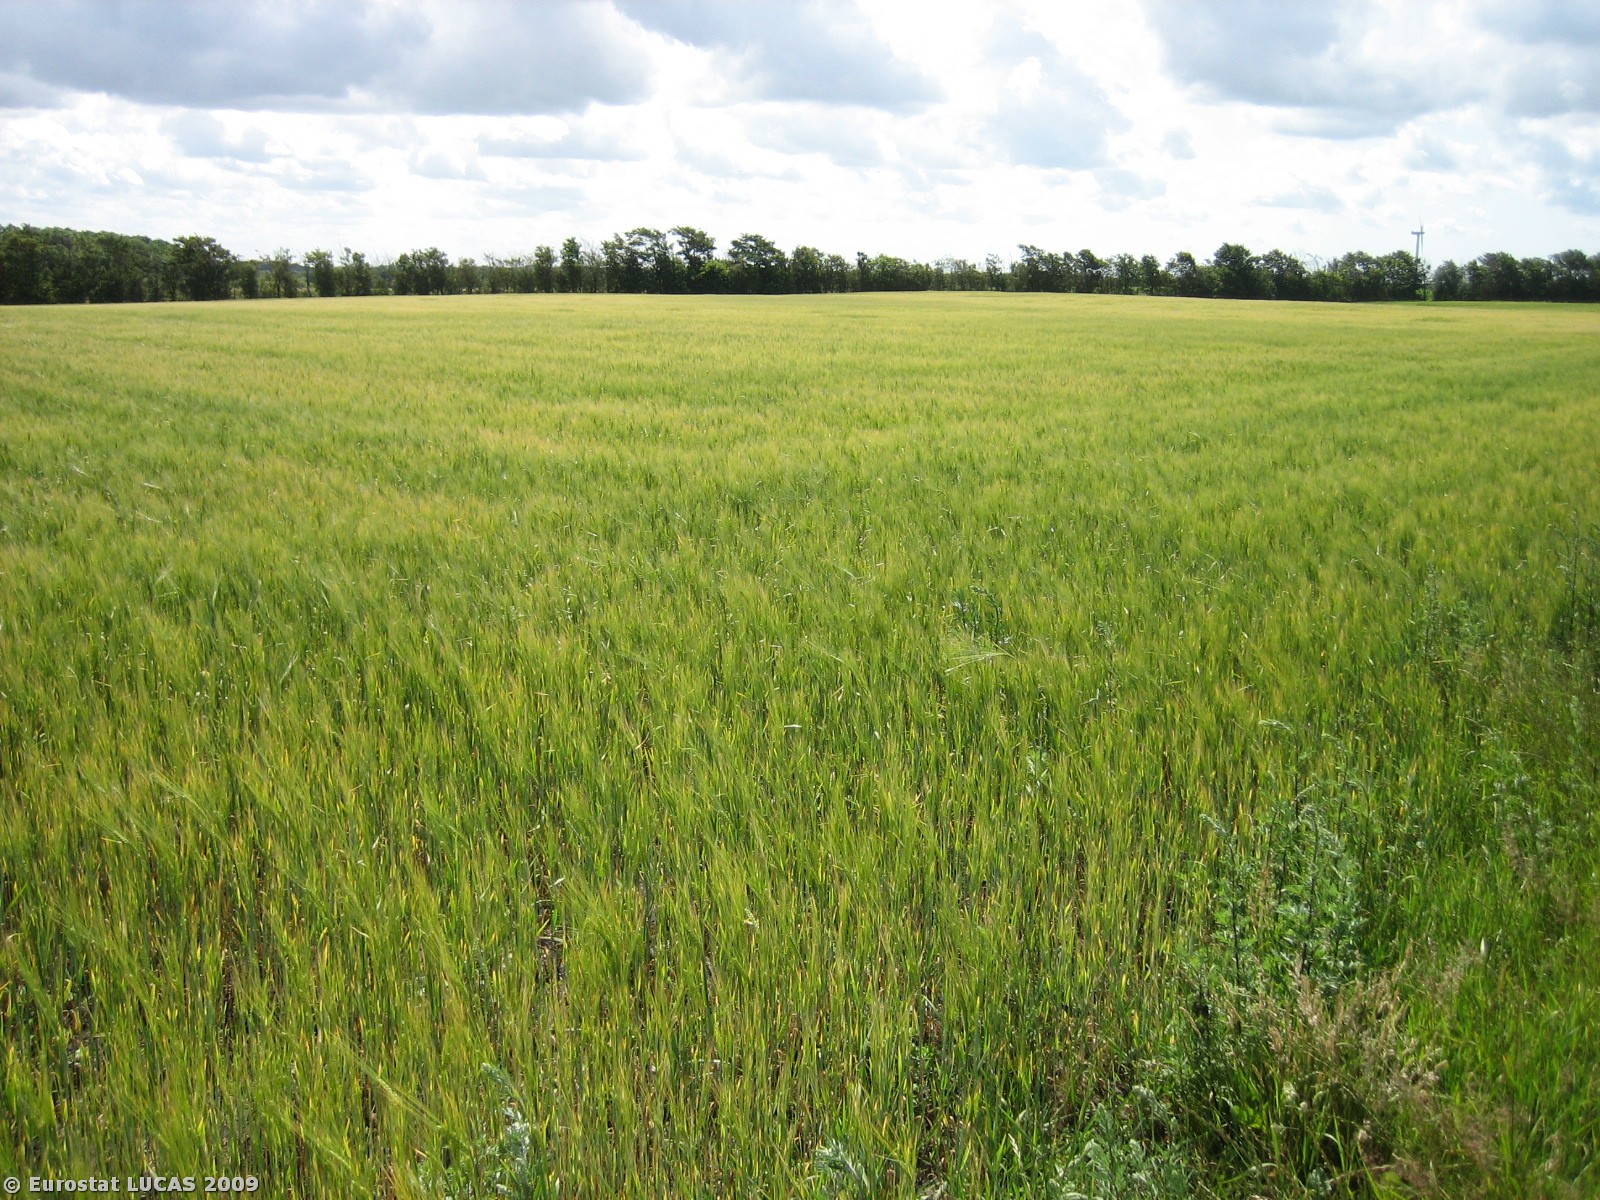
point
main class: Cropland
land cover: Barley
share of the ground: > 75 %
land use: Agriculture (excluding fallow land and kitchen gardens)
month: July
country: DK
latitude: 55.7481
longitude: 8.5517
